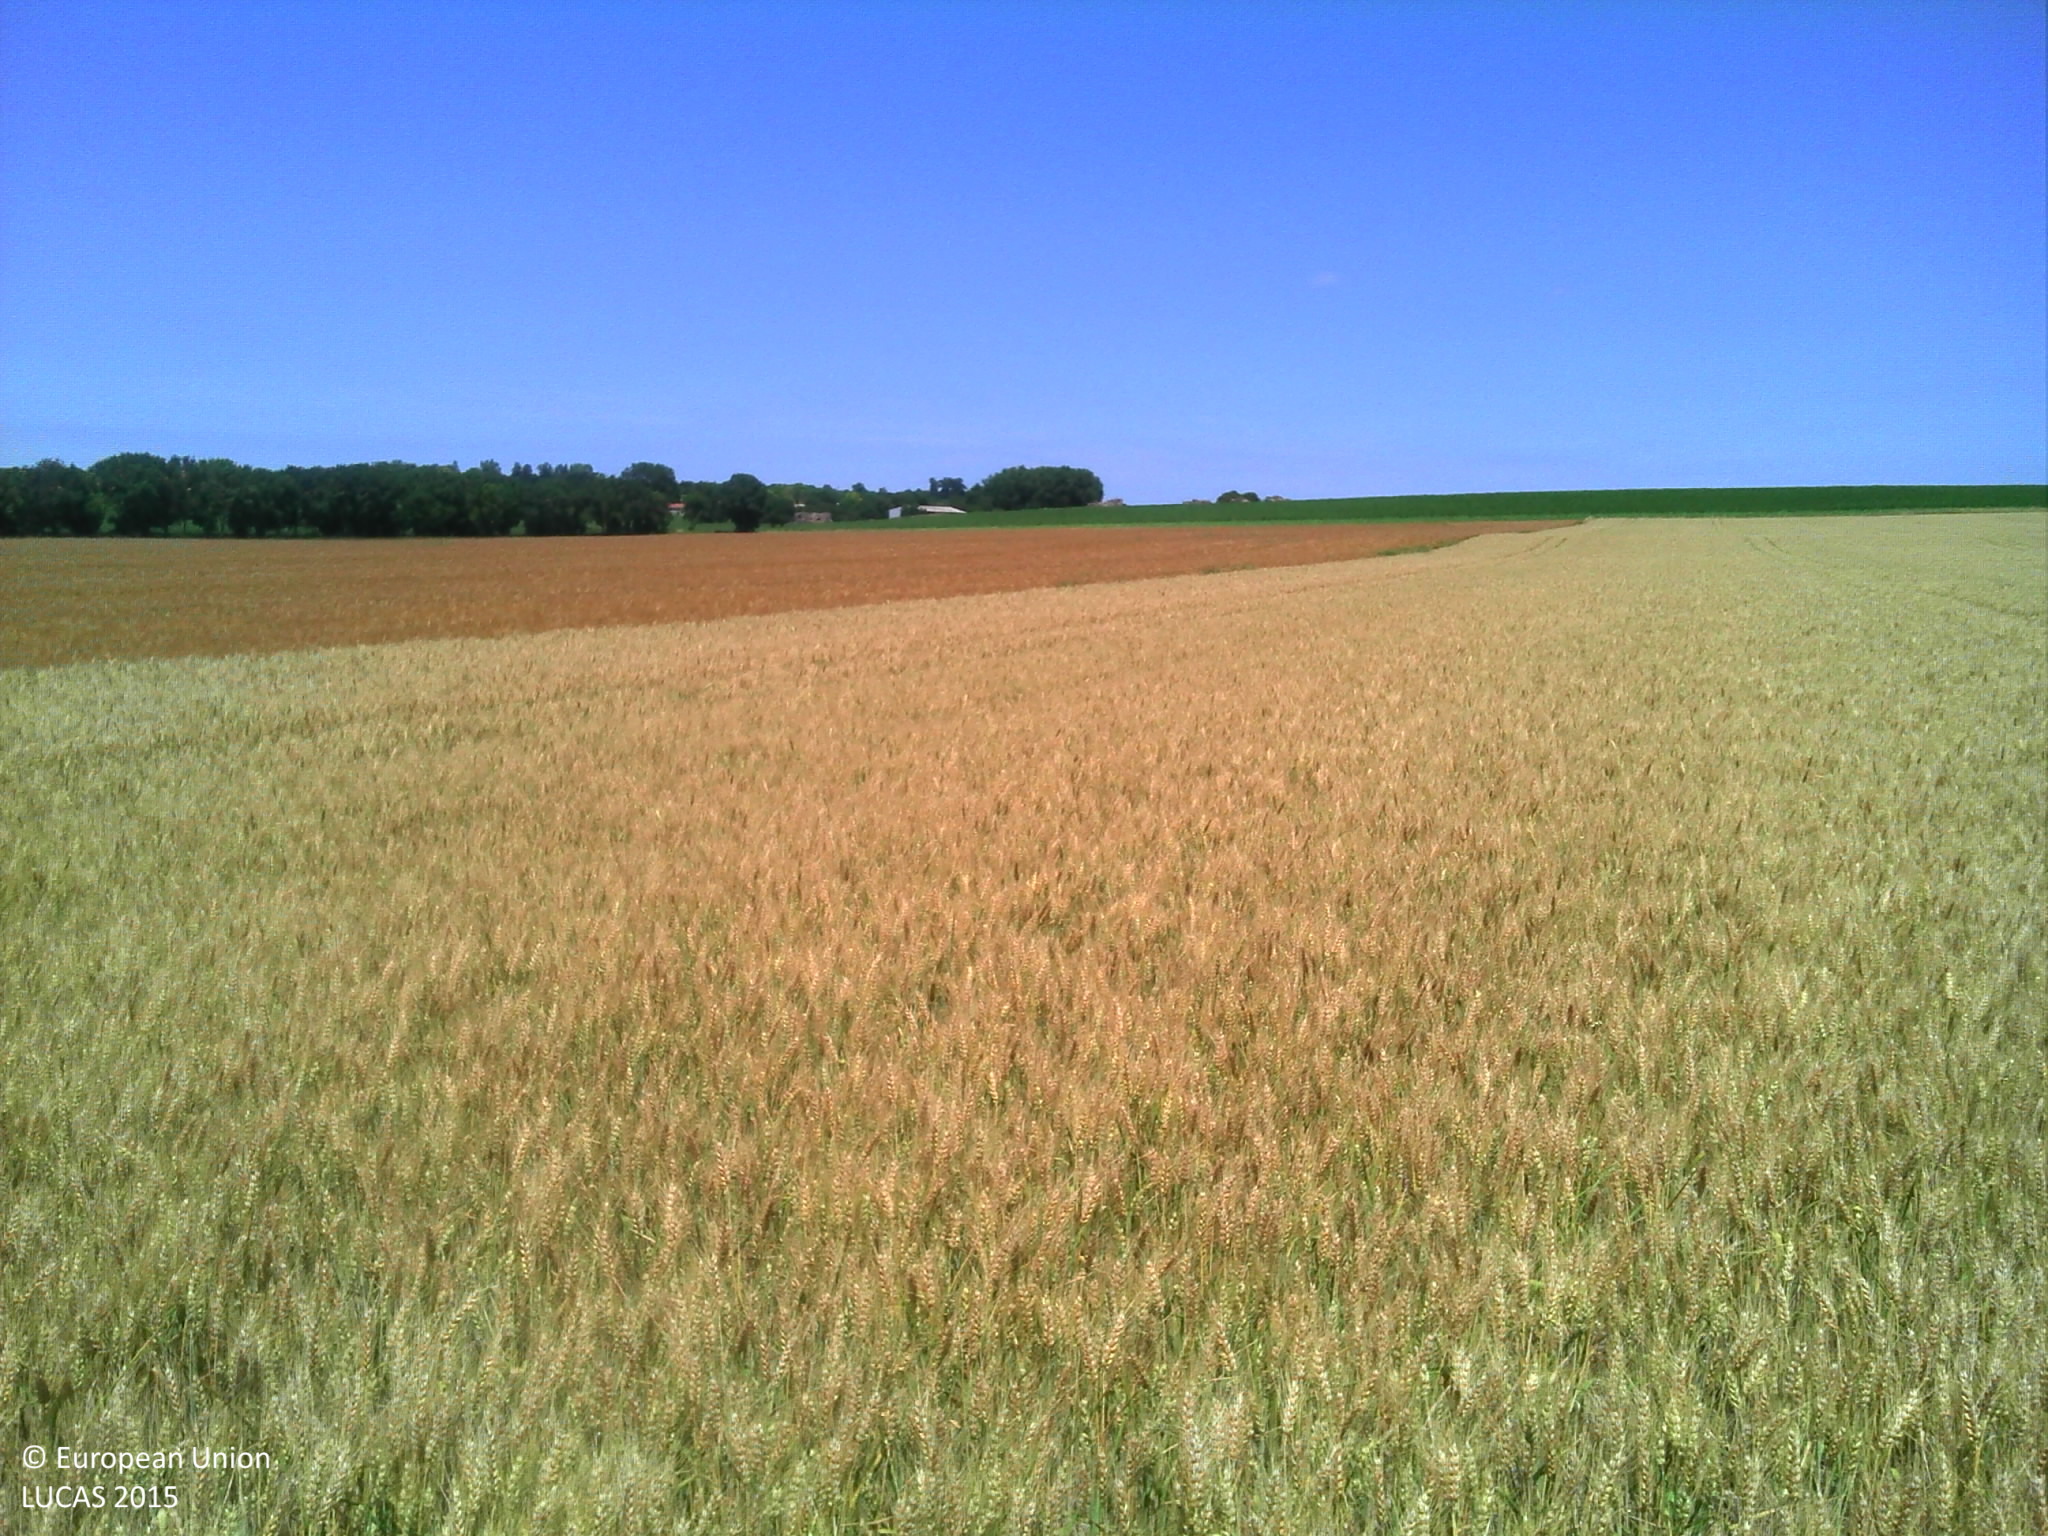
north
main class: Cropland
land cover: Durum wheat
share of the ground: > 75 %
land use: Agriculture (excluding fallow land and kitchen gardens)
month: June
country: FR
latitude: 45.5613
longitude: -0.8512
